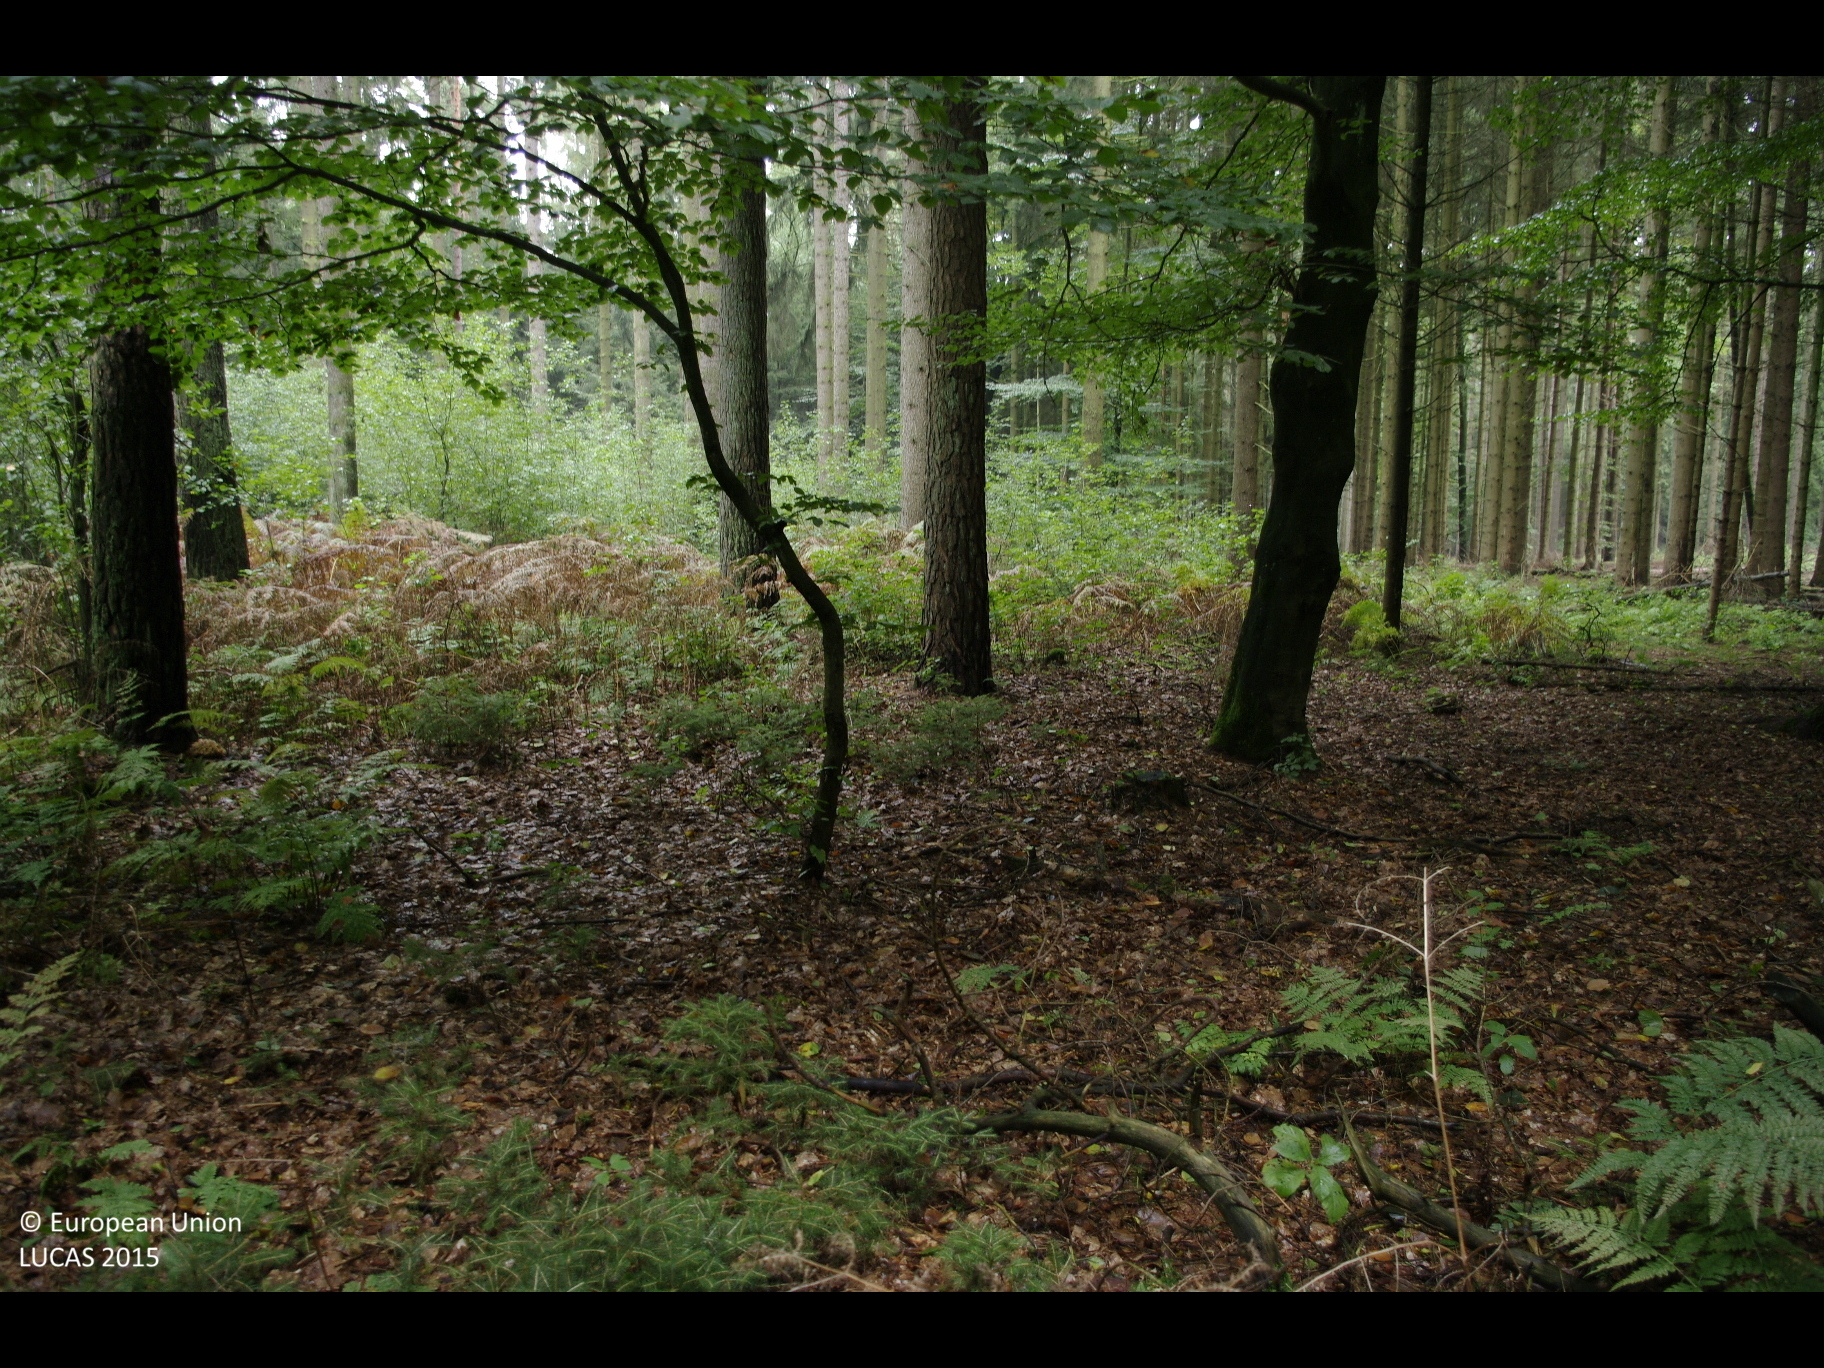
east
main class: Woodland
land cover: Pine dominated mixed woodland
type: hemiboreal forest and nemoral coniferous forest and mixed broadleaved-coniferous forest
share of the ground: > 75 %
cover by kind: coniferous forest trees 50 %, broadleaved forest trees 40 %, herbaceous plants 10 %
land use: Forestry
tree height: > 5 m
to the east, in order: Pine dominated mixed woodland; Spruce dominated coniferous woodland; Spruce dominated mixed woodland
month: September
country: DE
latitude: 53.3839
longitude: 9.9249
